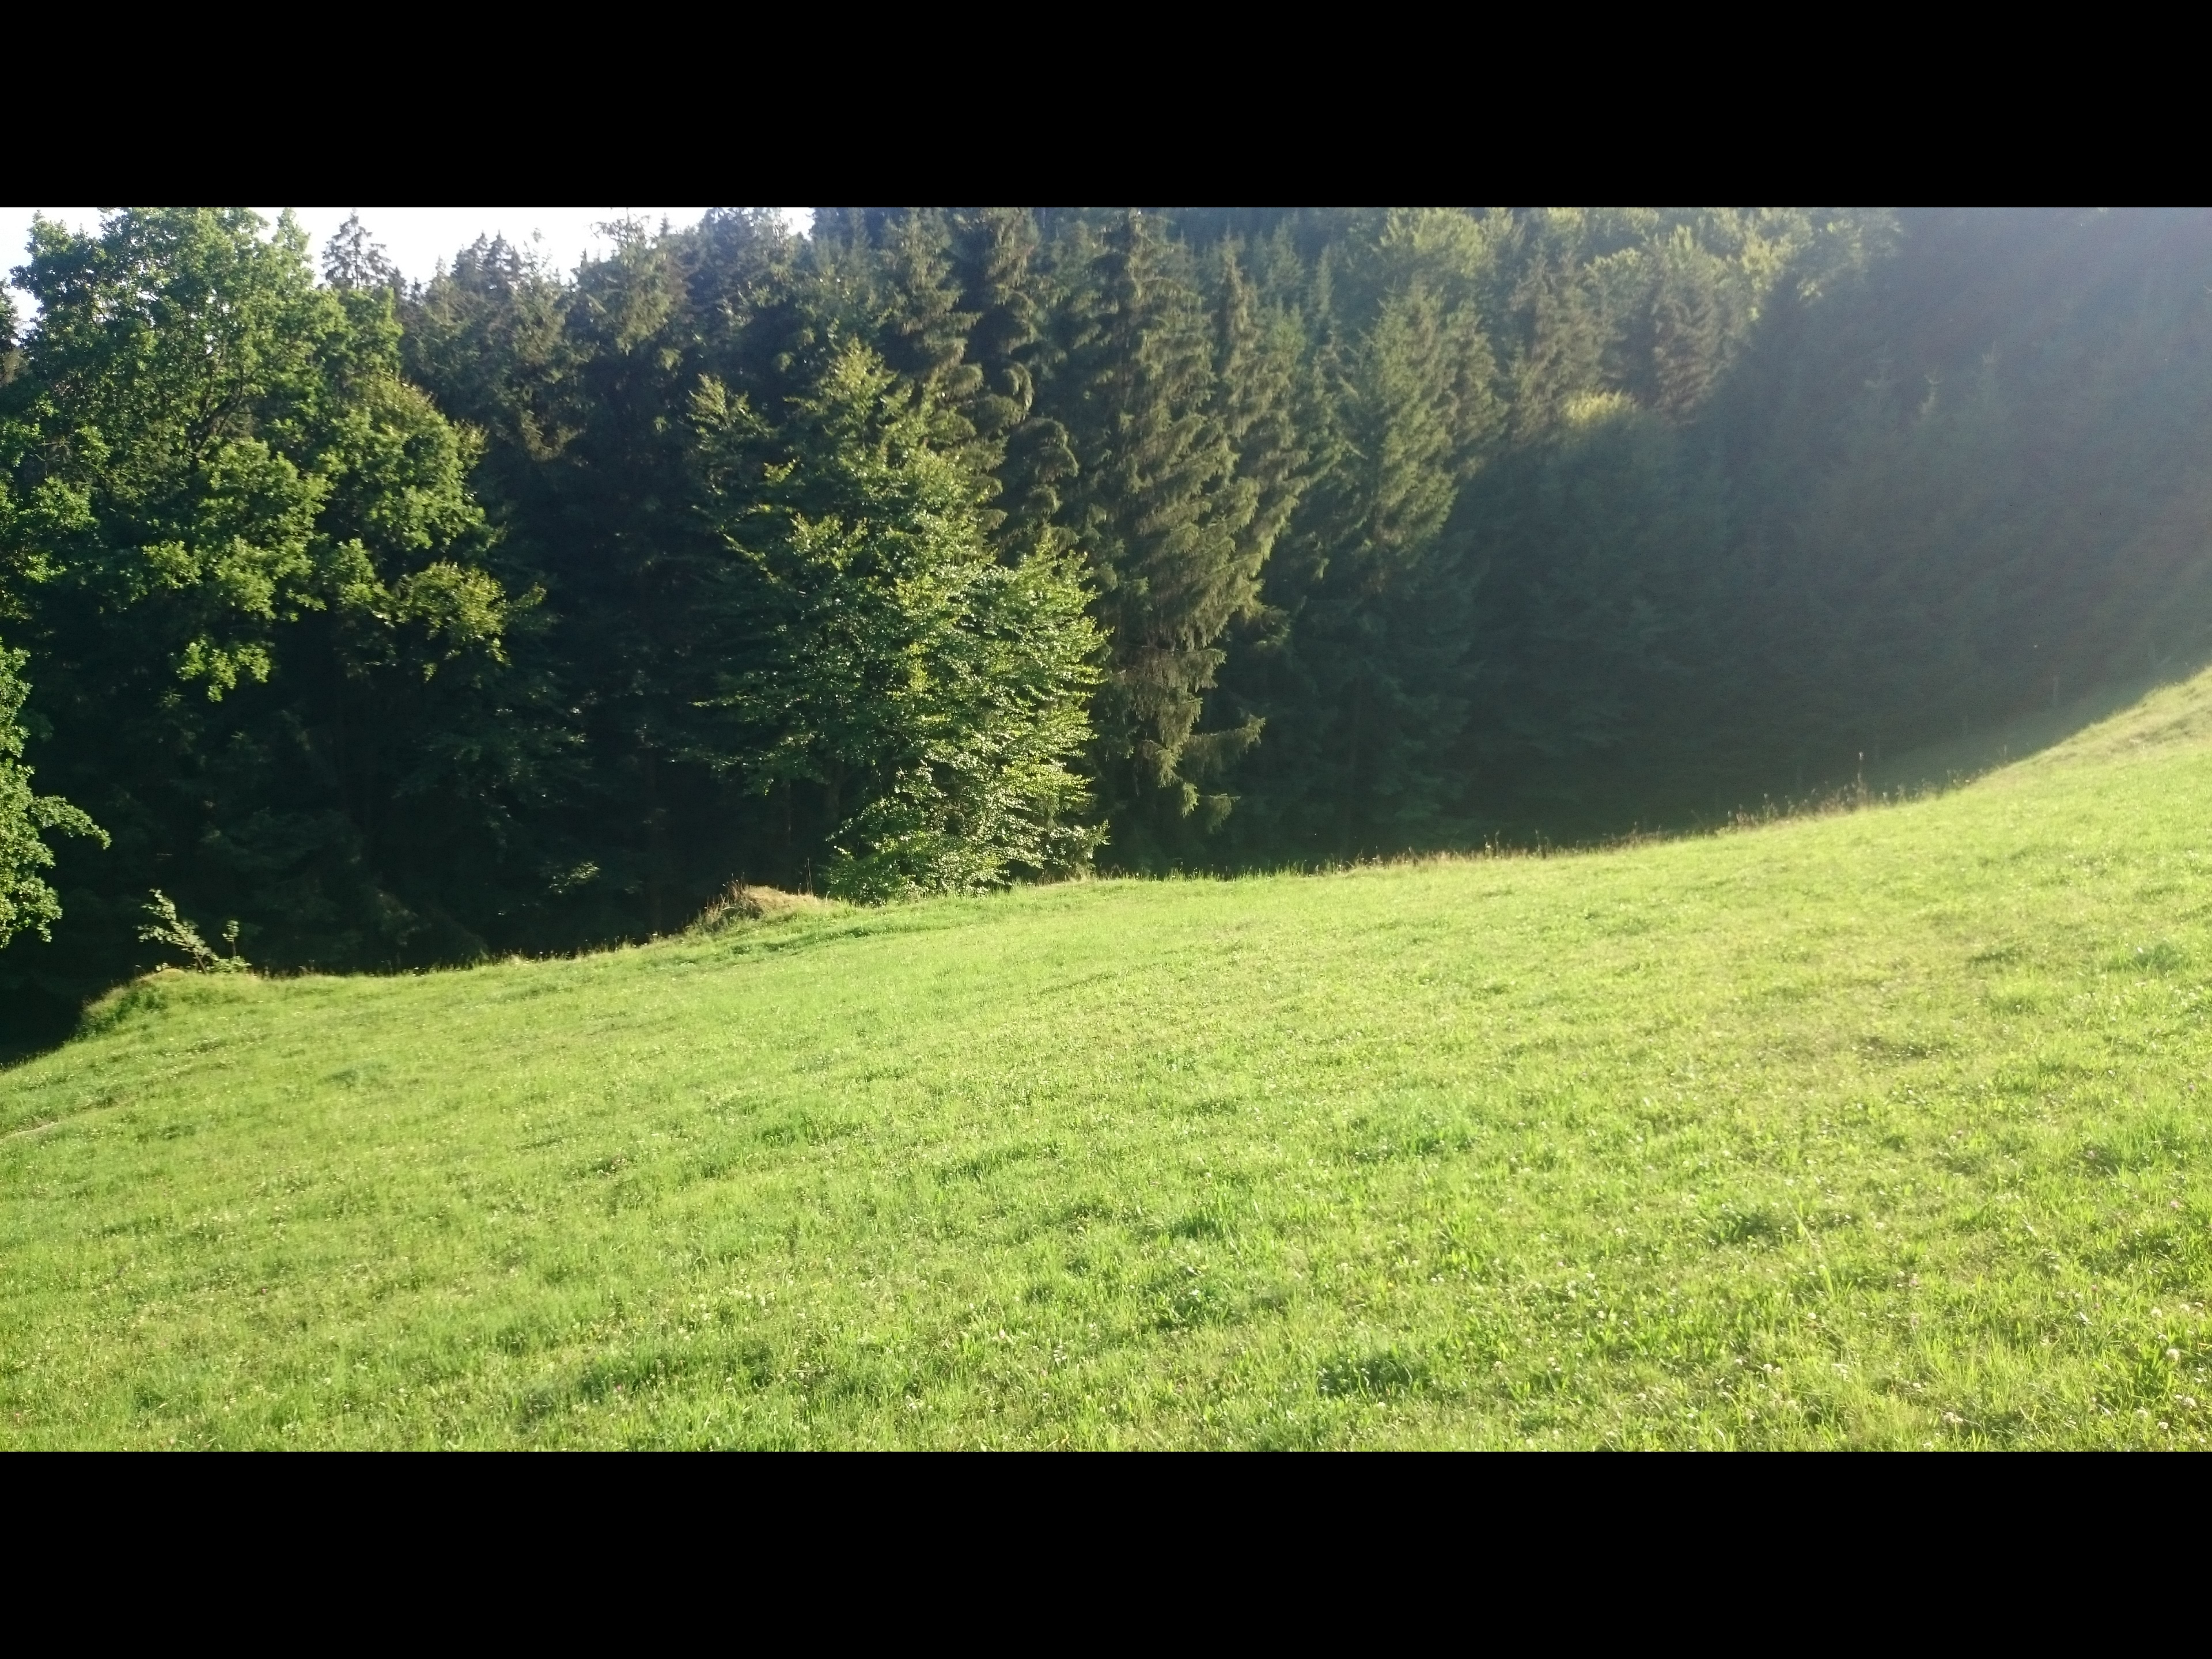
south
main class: Grassland
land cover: Grassland without tree/shrub cover
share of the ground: > 75 %
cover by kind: herbaceous plants 90 %, consolidated bare surface 5 %, unconsolidated bare surface 5 %
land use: Agriculture (excluding fallow land and kitchen gardens)
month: July
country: AT
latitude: 48.2891
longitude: 15.0286
